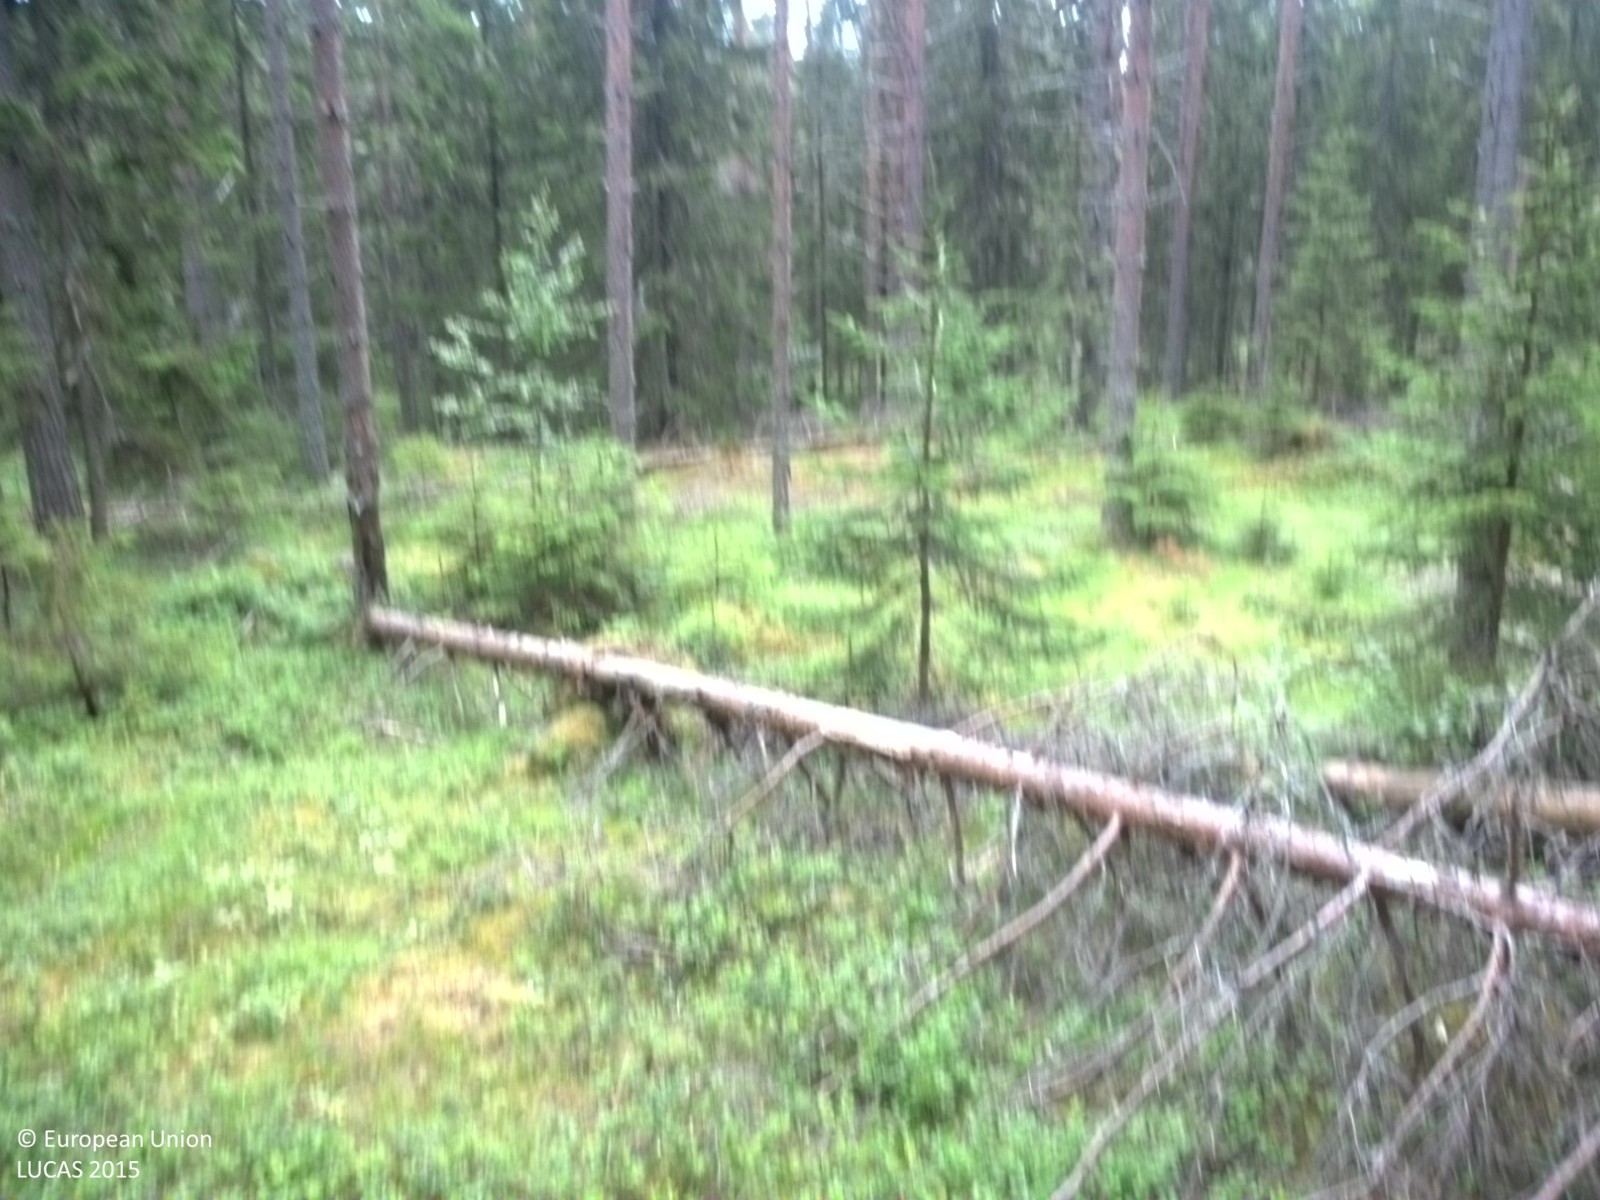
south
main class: Woodland
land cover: Pine dominated coniferous woodland
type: boreal forest
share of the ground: 50 - 75 %
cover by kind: coniferous forest trees 65 %, shrubs 20 %, broadleaved forest trees 10 %, herbaceous plants 5 %
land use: Forestry
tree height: > 5 m
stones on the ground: < 10 %
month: July
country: SE
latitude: 63.7093
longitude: 19.5502
